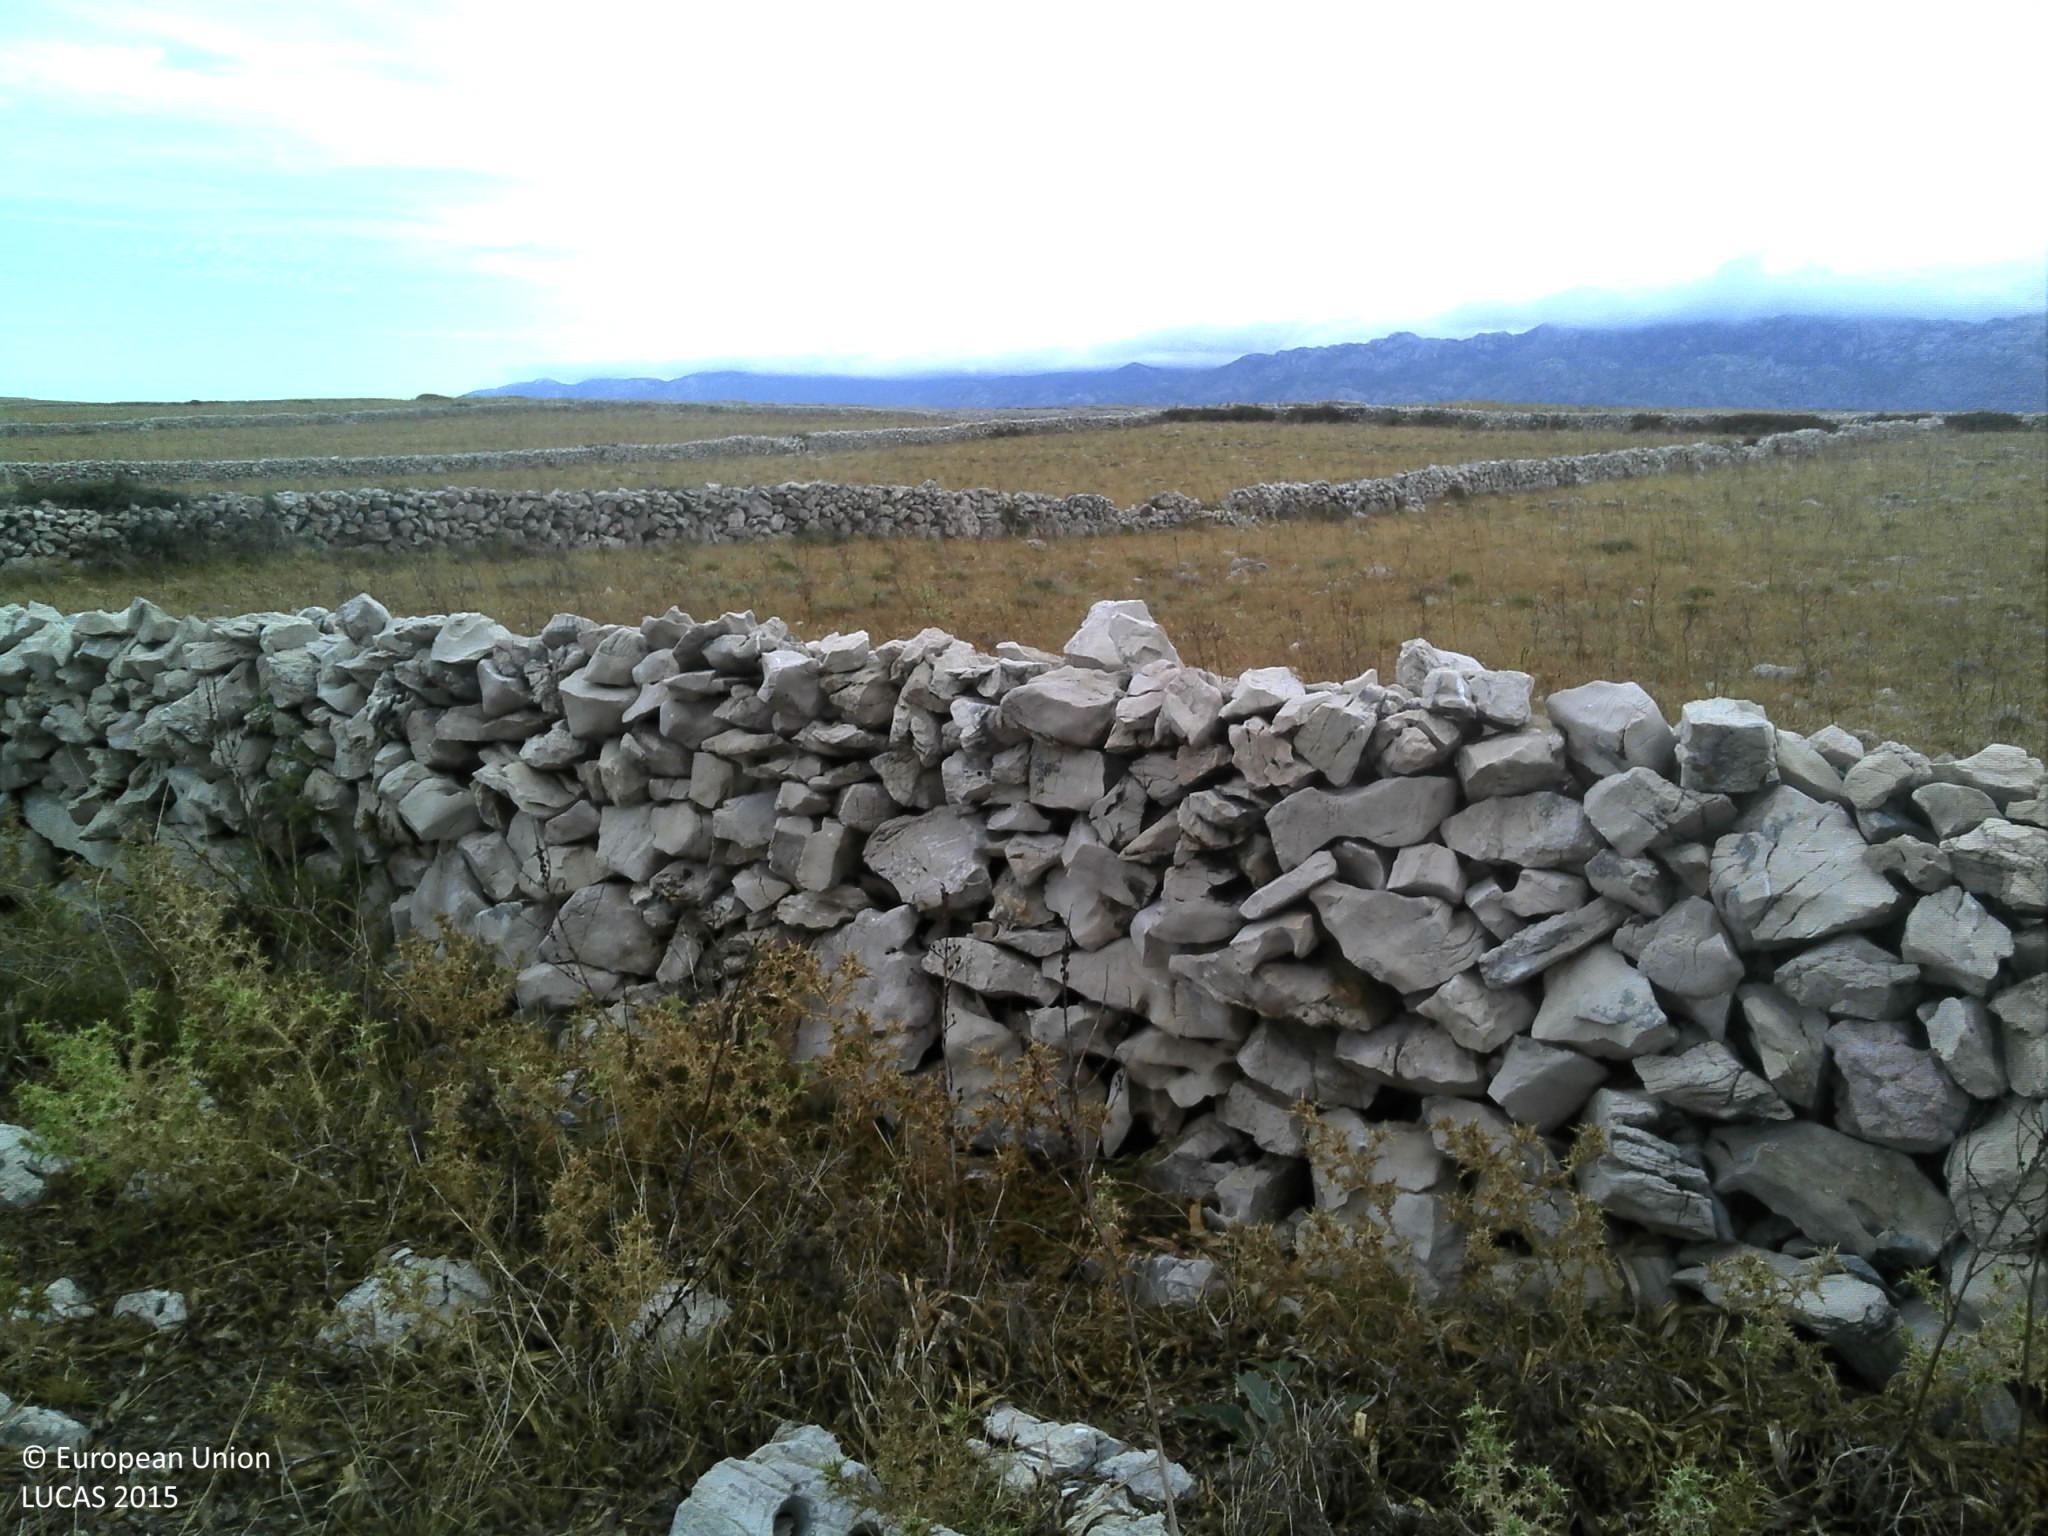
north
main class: Grassland
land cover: Grassland without tree/shrub cover
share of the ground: 50 - 75 %
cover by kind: herbaceous plants 45 %, unconsolidated bare surface 40 %, consolidated bare surface 10 %, shrubs 5 %
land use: Agriculture (excluding fallow land and kitchen gardens)
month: July
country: HR
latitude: 44.3672
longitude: 15.1501
